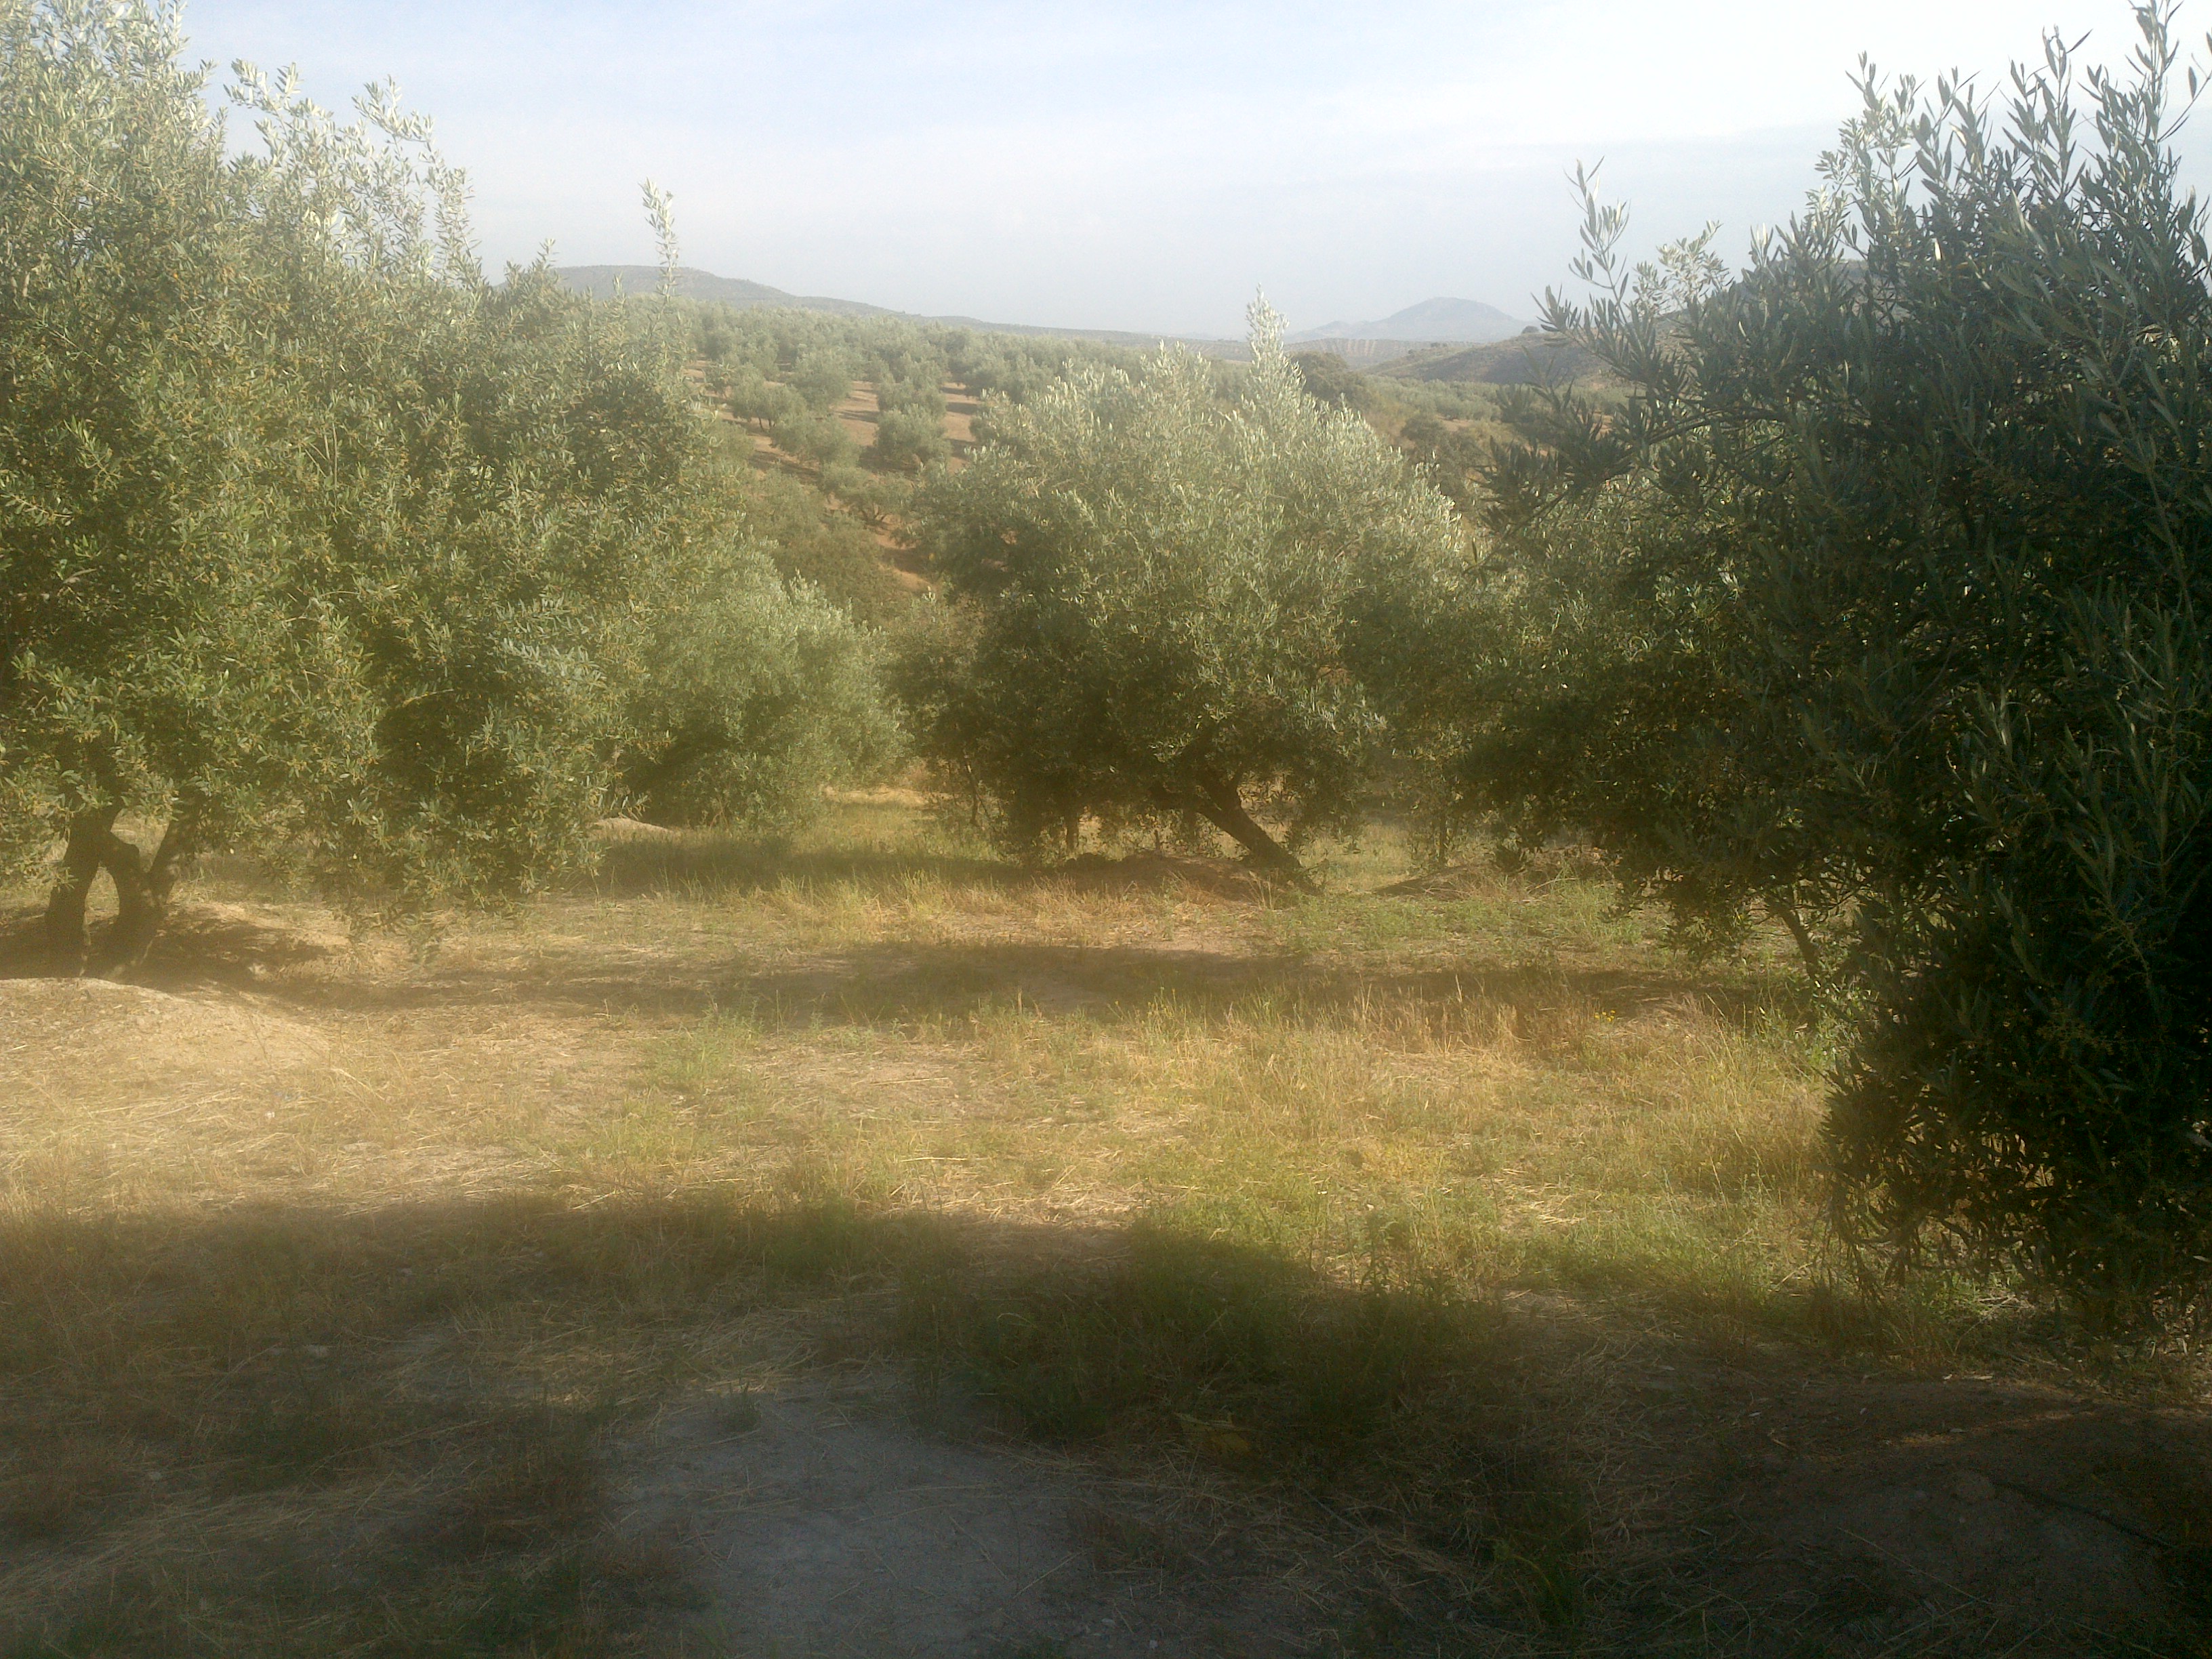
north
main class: Cropland
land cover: Olive groves
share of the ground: 25 - 50 %
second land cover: Spontaneously vegetated surfaces
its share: 50 - 75 %
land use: Agriculture (excluding fallow land and kitchen gardens)
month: May
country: ES
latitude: 37.4634
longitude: -4.0976
